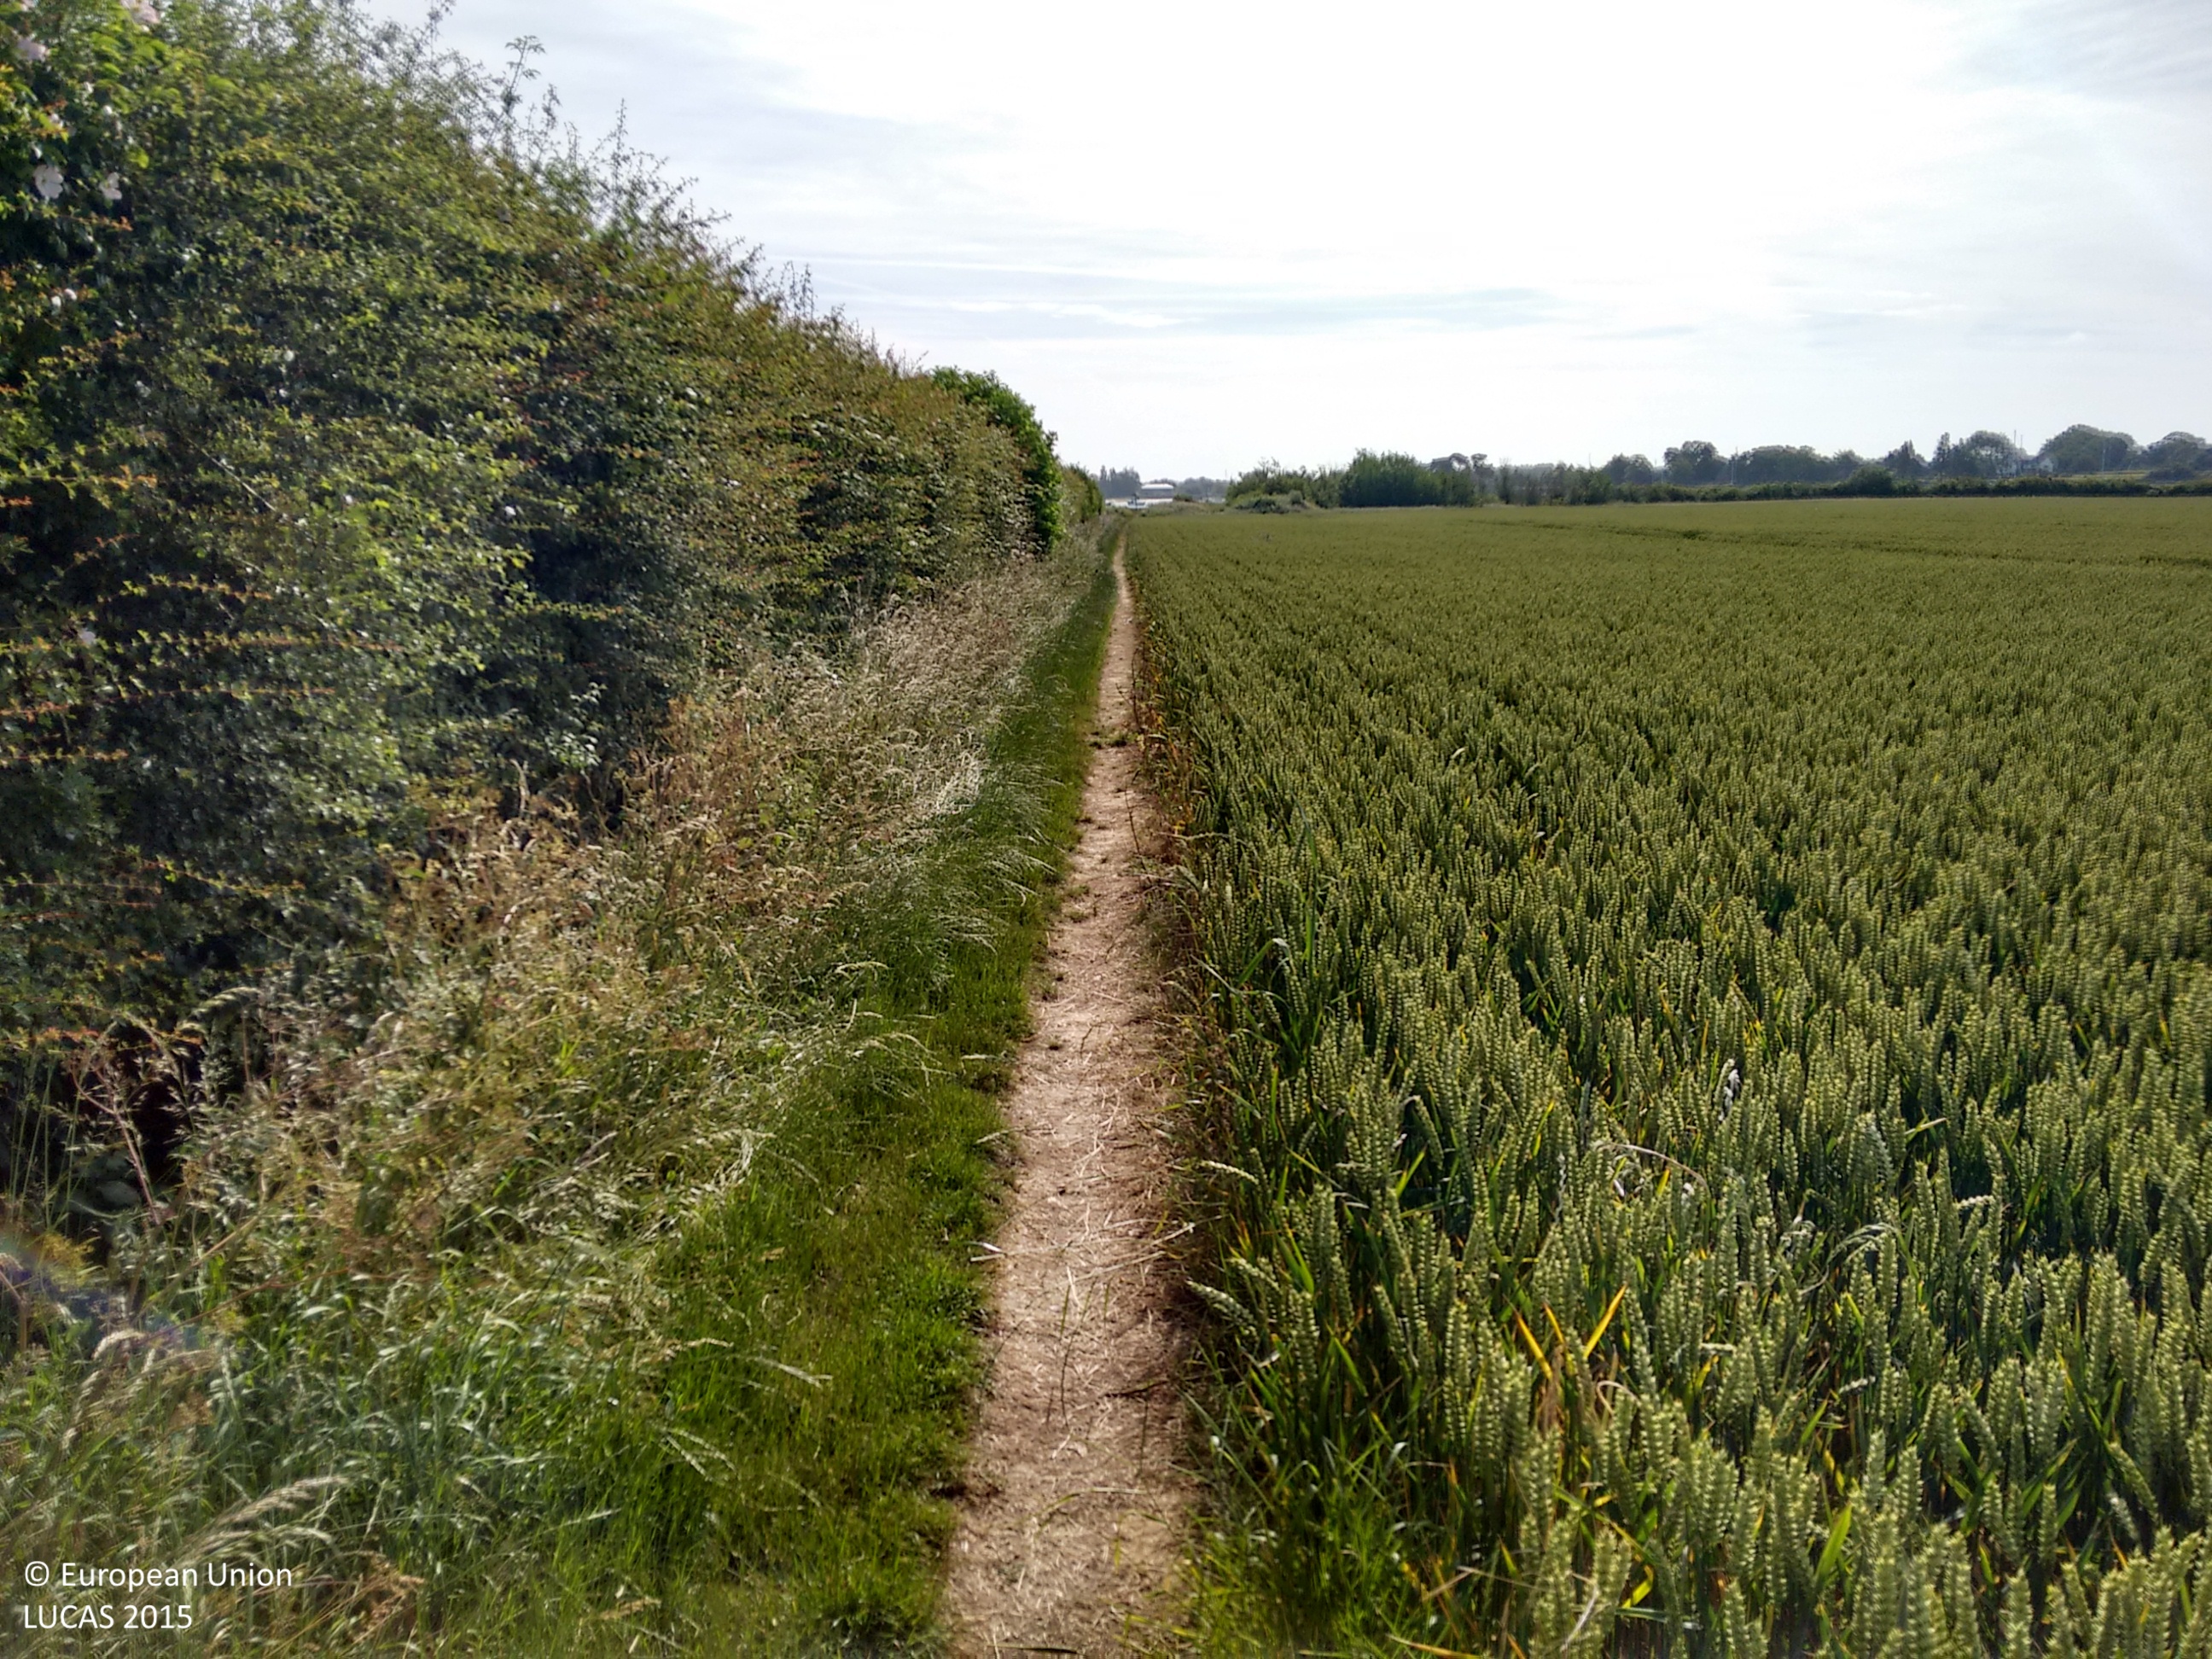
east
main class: Cropland
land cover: Common wheat
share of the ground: 50 - 75 %
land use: Agriculture (excluding fallow land and kitchen gardens)
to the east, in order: Common wheat; Grassland without tree/shrub cover; Single bushes/trees; Grassland without tree/shrub cover
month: June
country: GB
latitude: 50.8239
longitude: -0.8742
